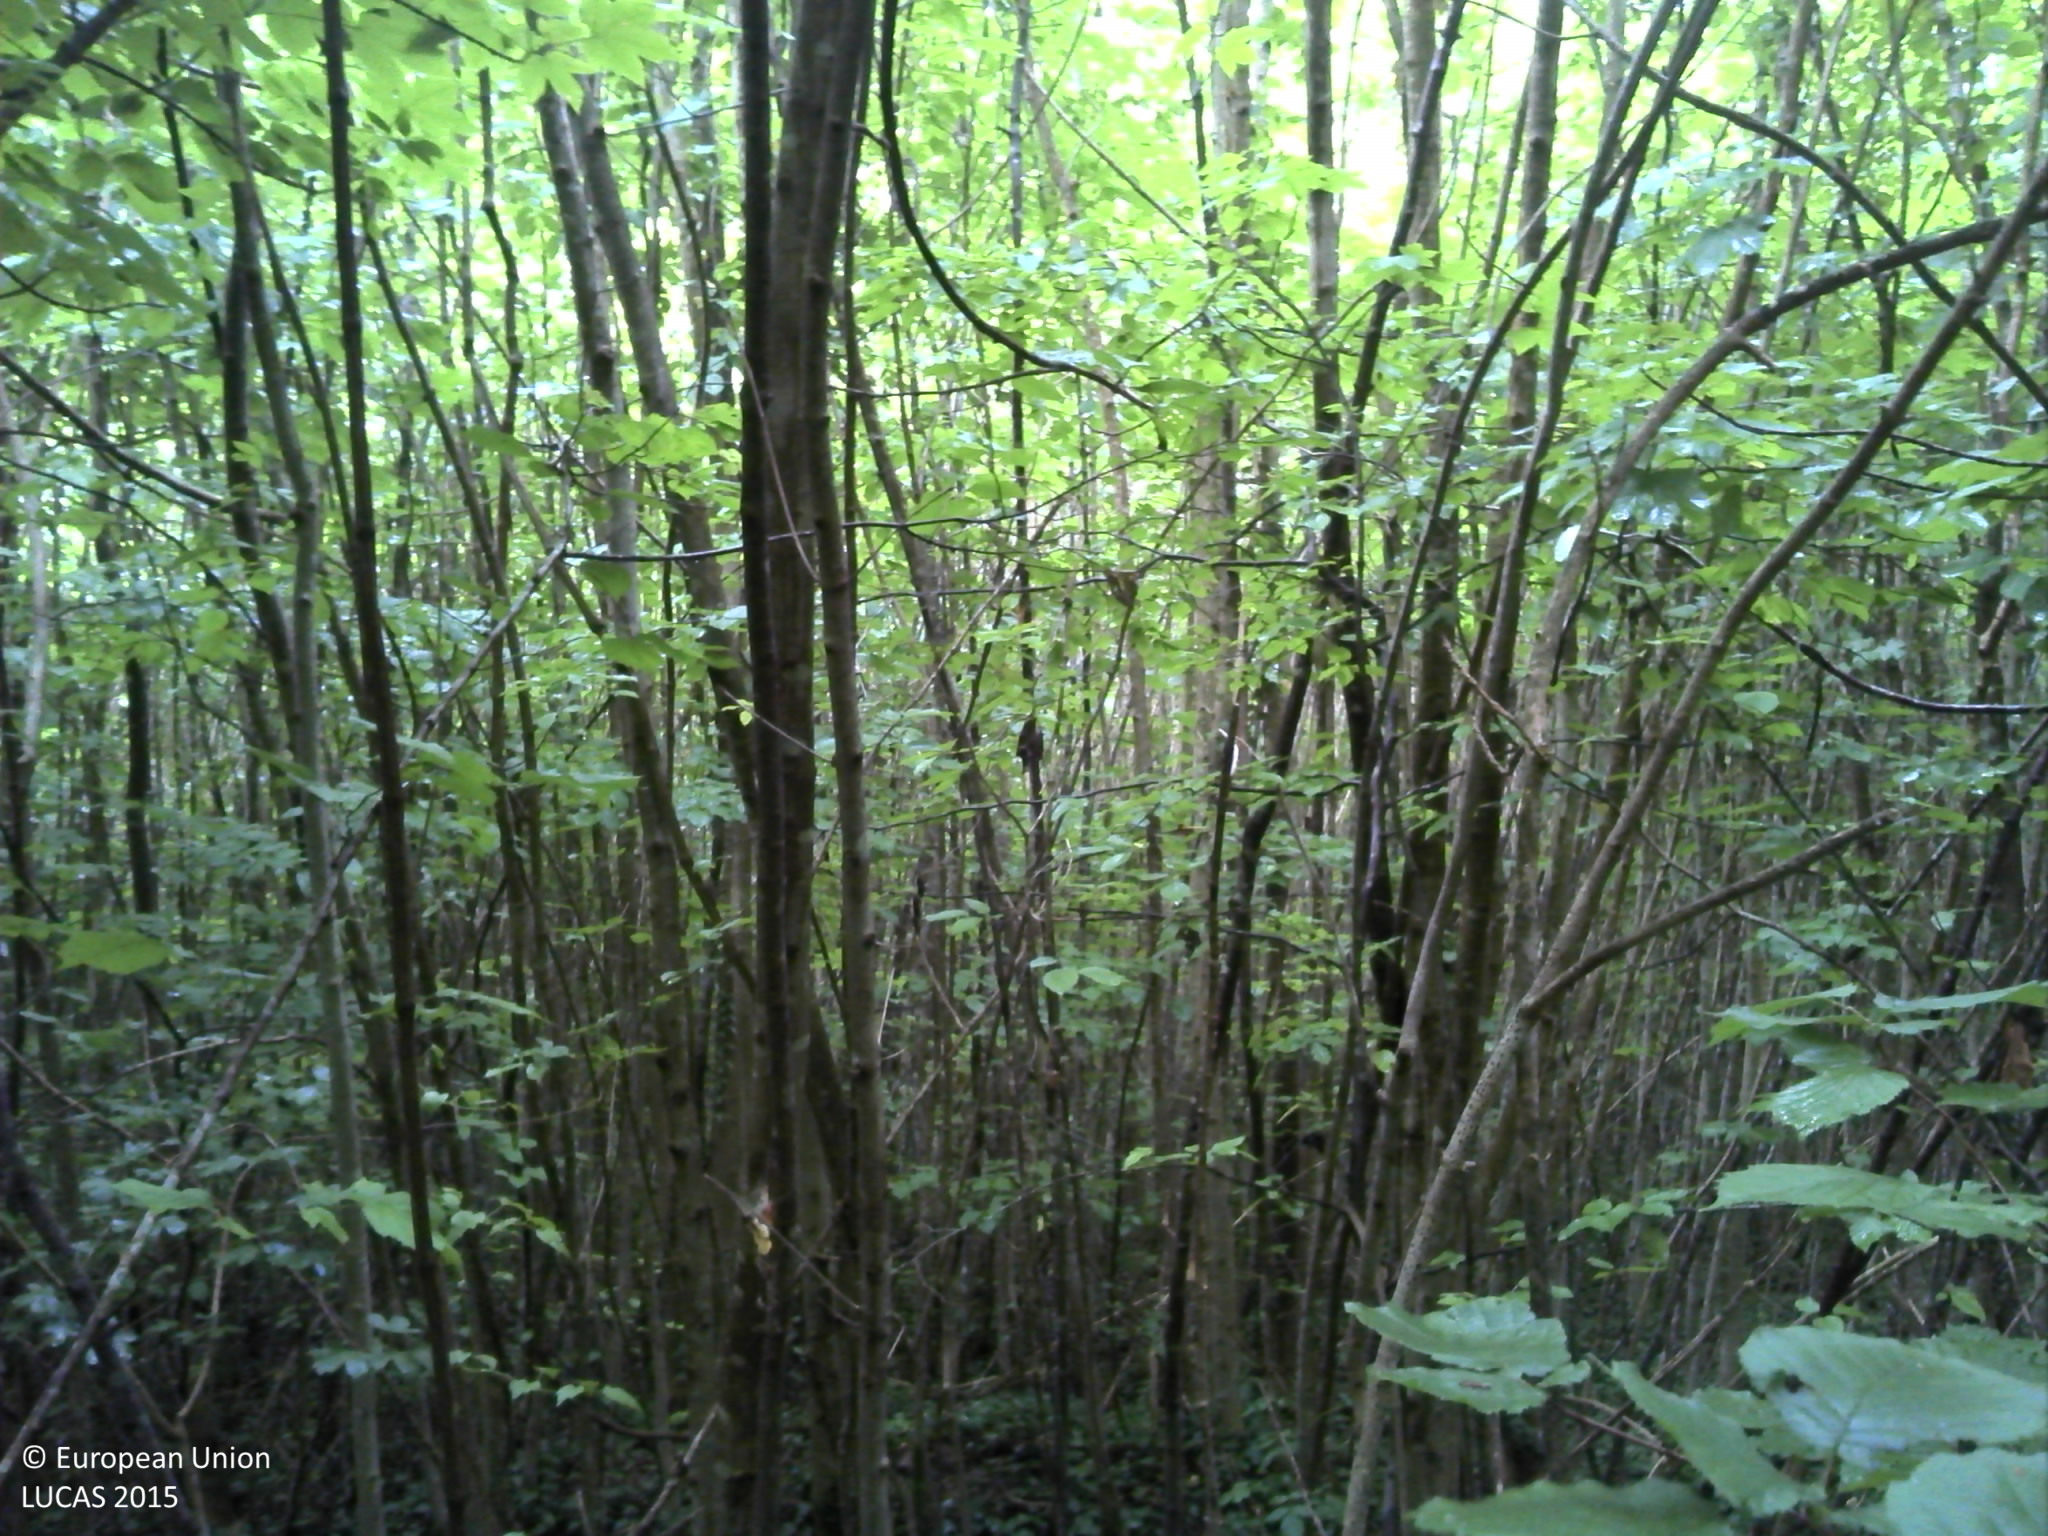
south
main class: Woodland
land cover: Broadleaved woodland
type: beech forest
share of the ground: > 75 %
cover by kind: broadleaved forest trees 75 %, herbaceous plants 15 %, consolidated bare surface 10 %
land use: Forestry
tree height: > 5 m
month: July
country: FR
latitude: 49.6794
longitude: 4.6331
